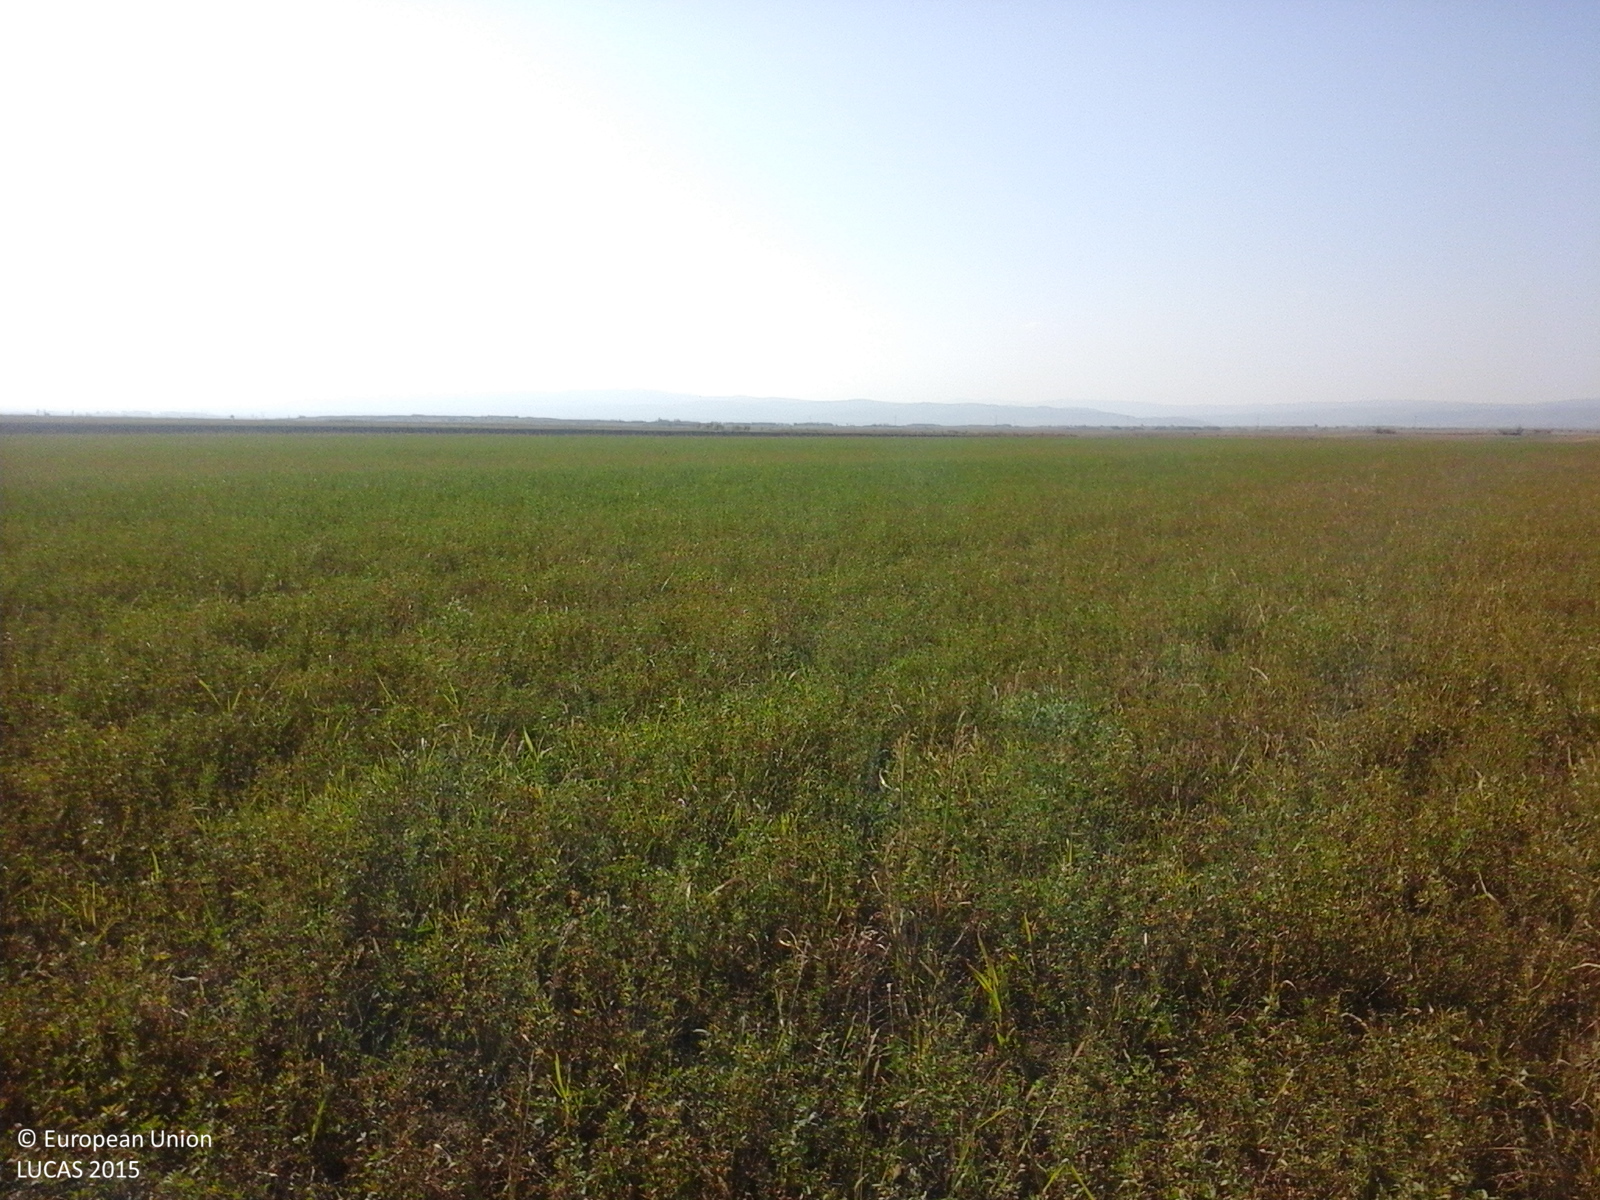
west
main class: Cropland
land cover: Lucerne
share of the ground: > 75 %
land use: Agriculture (excluding fallow land and kitchen gardens)
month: October
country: RO
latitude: 45.2086
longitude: 26.8232
